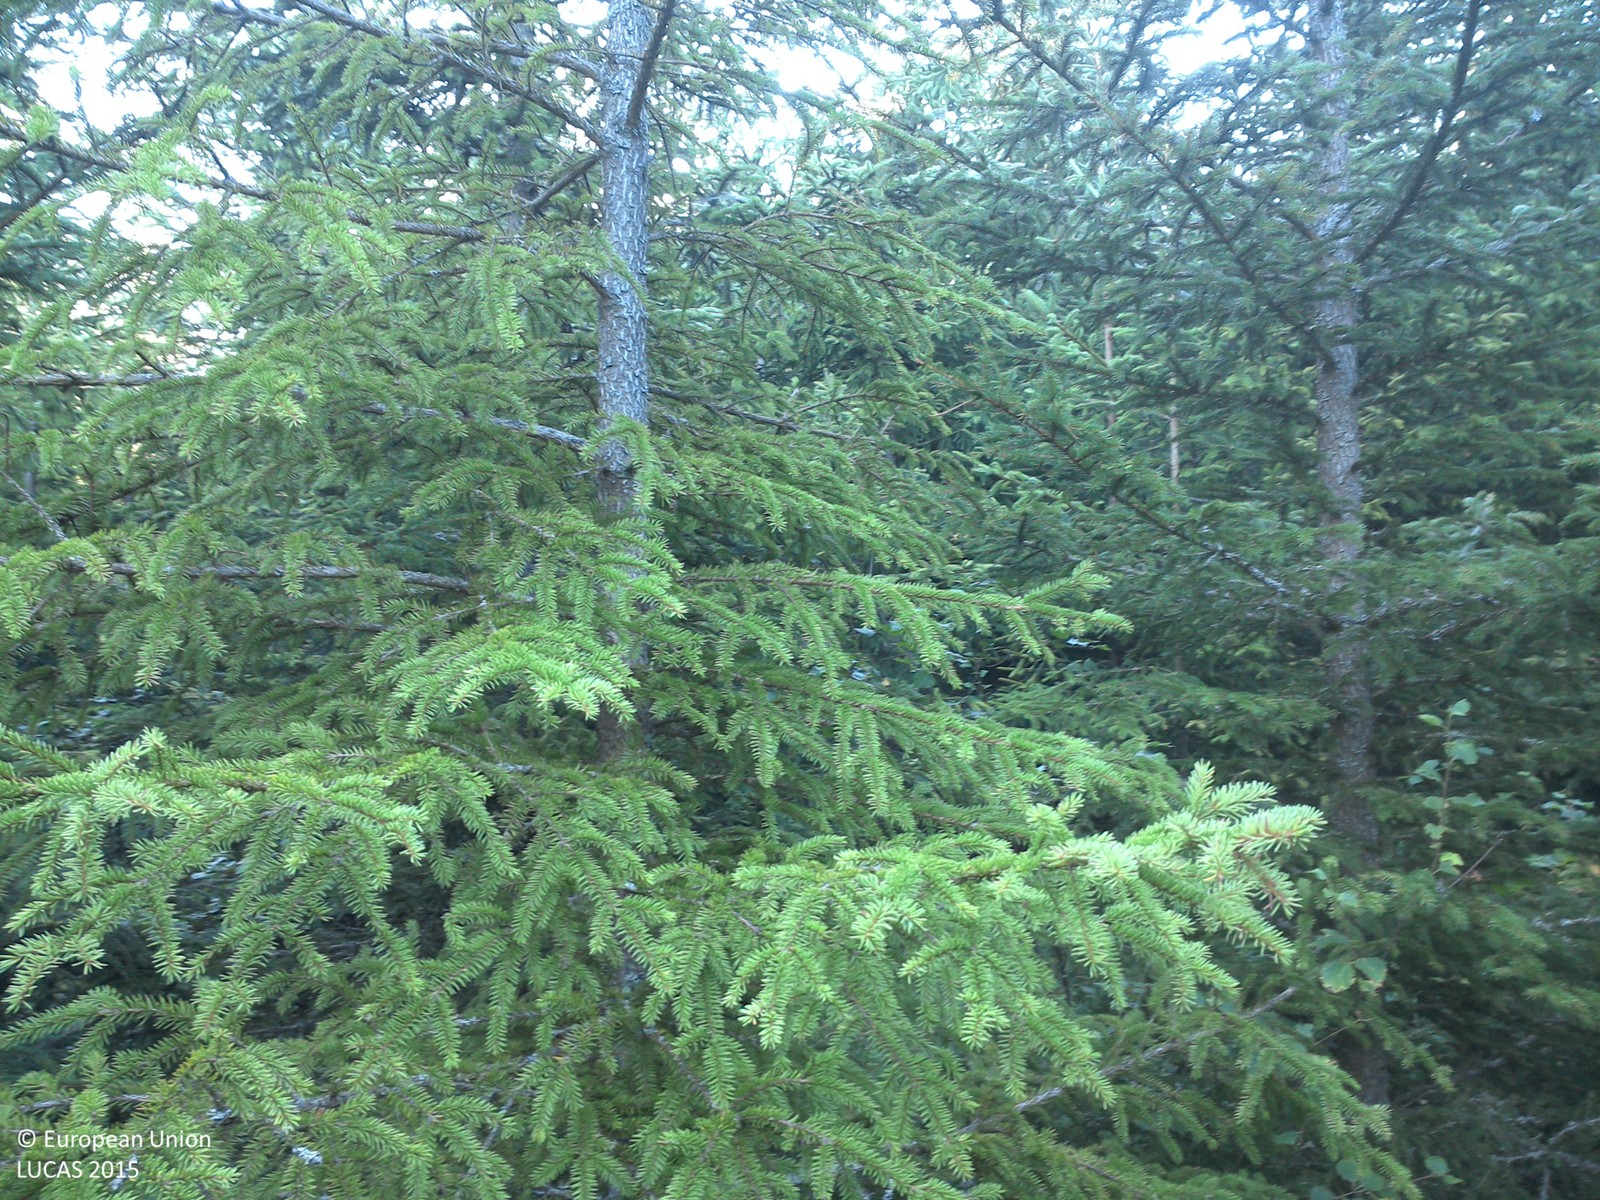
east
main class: Woodland
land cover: Spruce dominated coniferous woodland
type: boreal forest
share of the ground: > 75 %
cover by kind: coniferous forest trees 80 %, herbaceous plants 20 %
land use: Forestry
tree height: < 5 m
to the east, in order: Spruce dominated coniferous woodland; Pine dominated coniferous woodland; Broadleaved woodland; Spruce dominated coniferous woodland; Pine dominated coniferous woodland; Shrubland with sparse tree cover
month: August
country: SE
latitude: 58.0788
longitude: 14.8272
